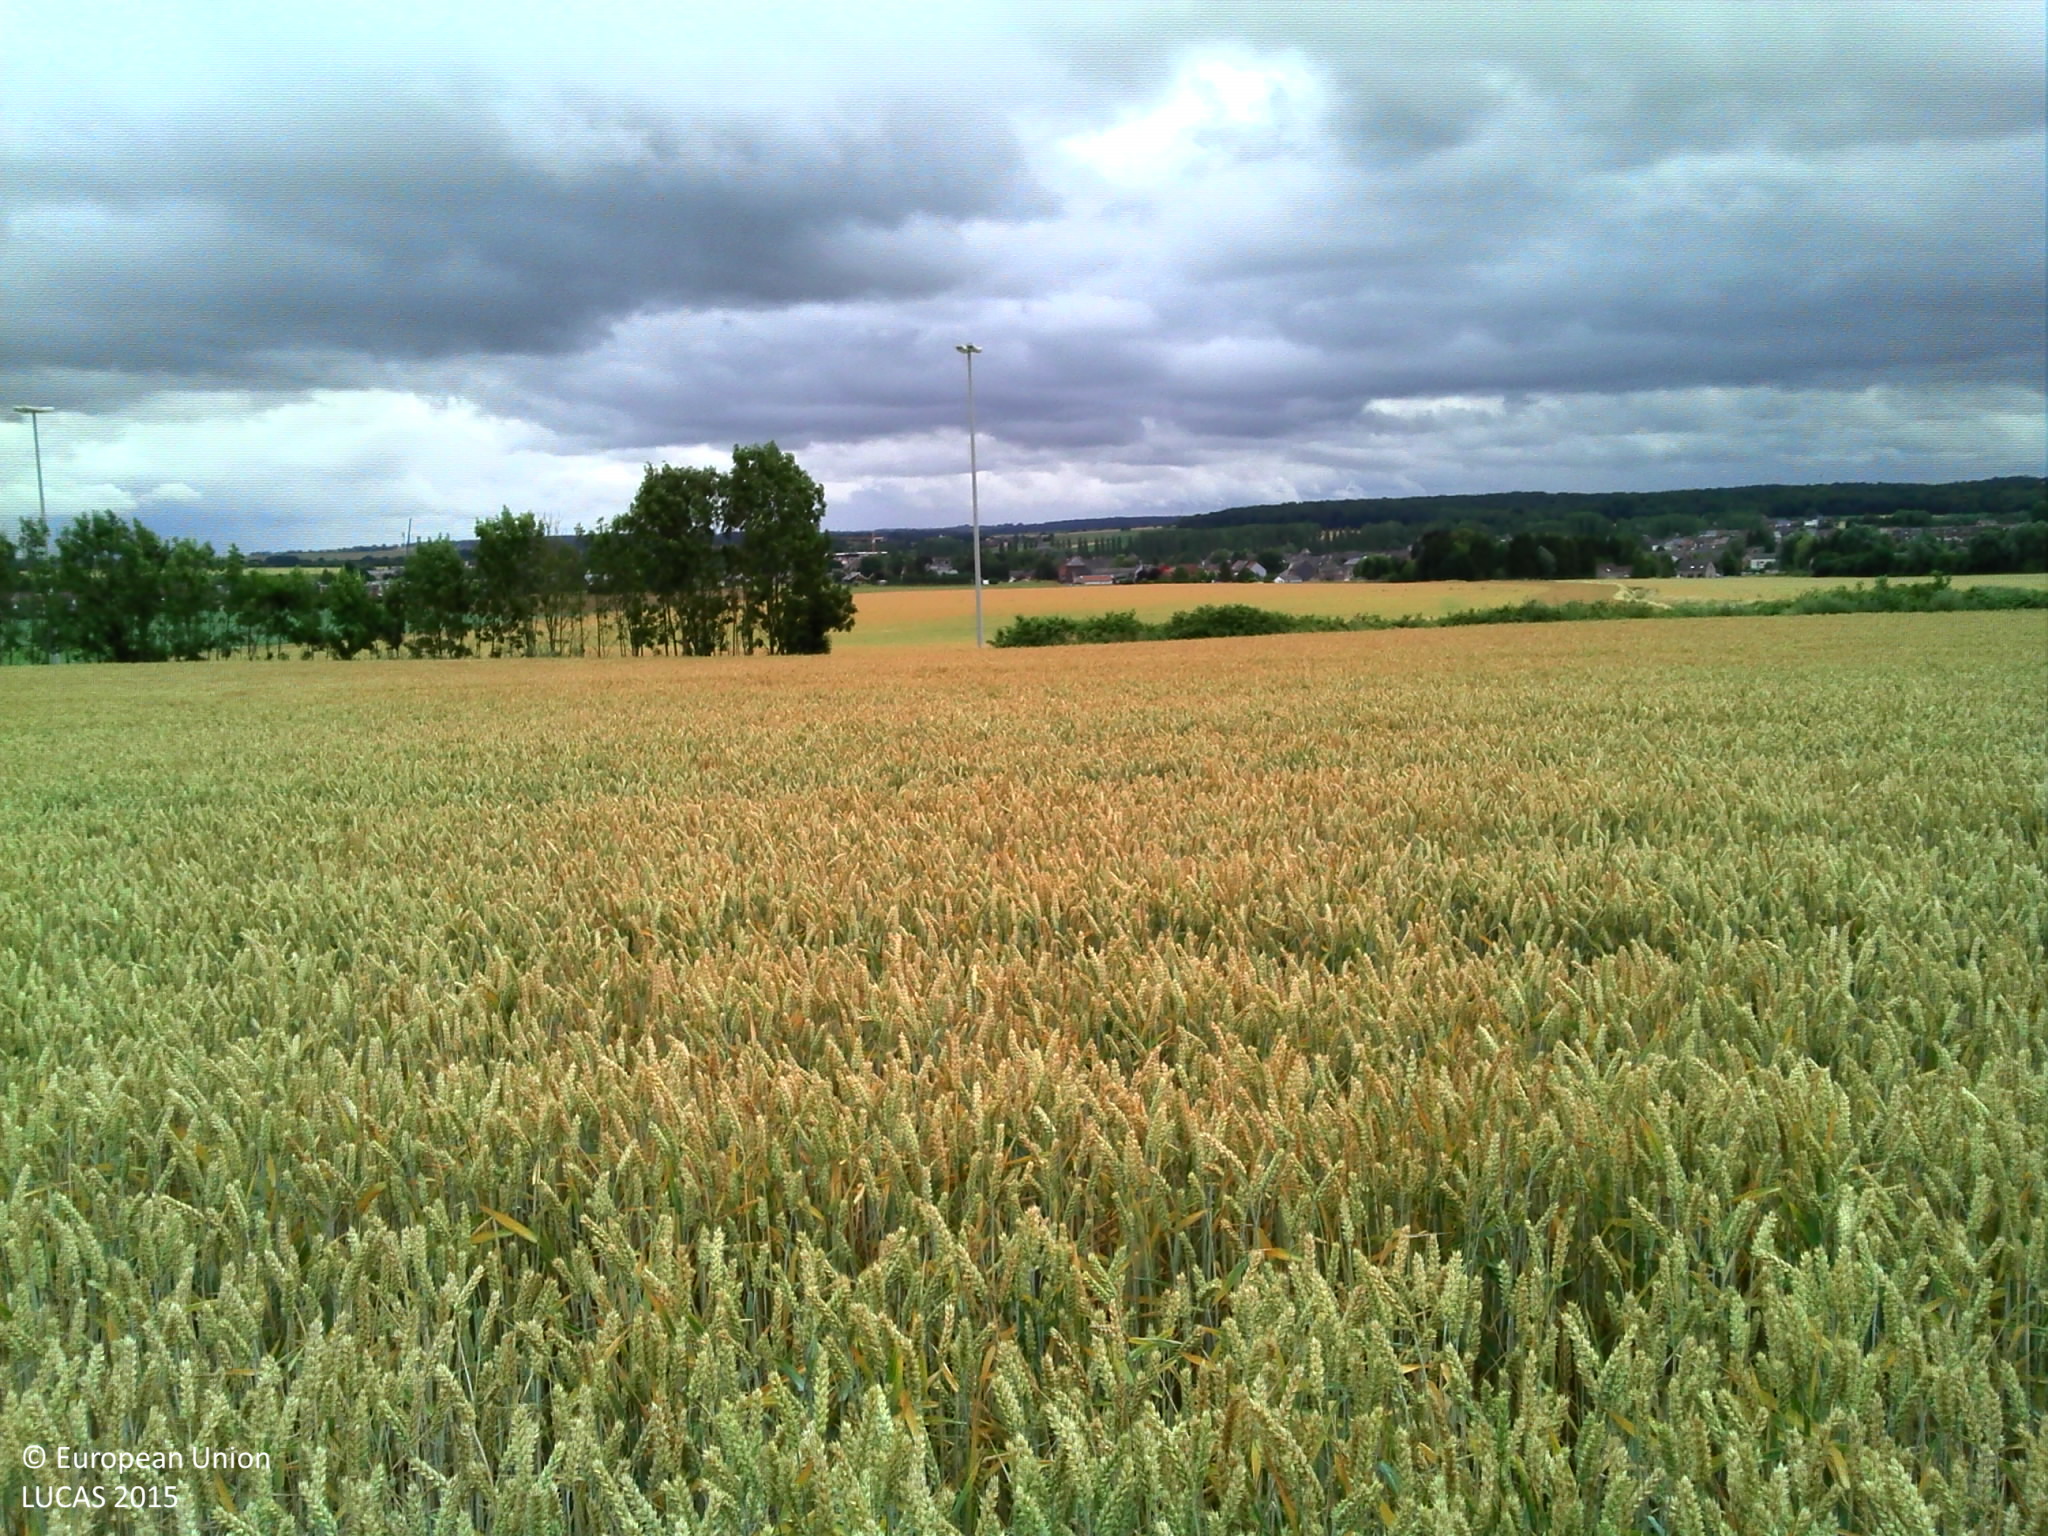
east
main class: Cropland
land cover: Common wheat
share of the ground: > 75 %
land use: Agriculture (excluding fallow land and kitchen gardens)
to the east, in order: Common wheat; Grass margins; Broadleaved woodland; Grass margins; Paved roads, cycling and walking lanes; Grass margins; Common wheat
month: July
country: BE
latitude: 50.3205
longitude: 4.1098
